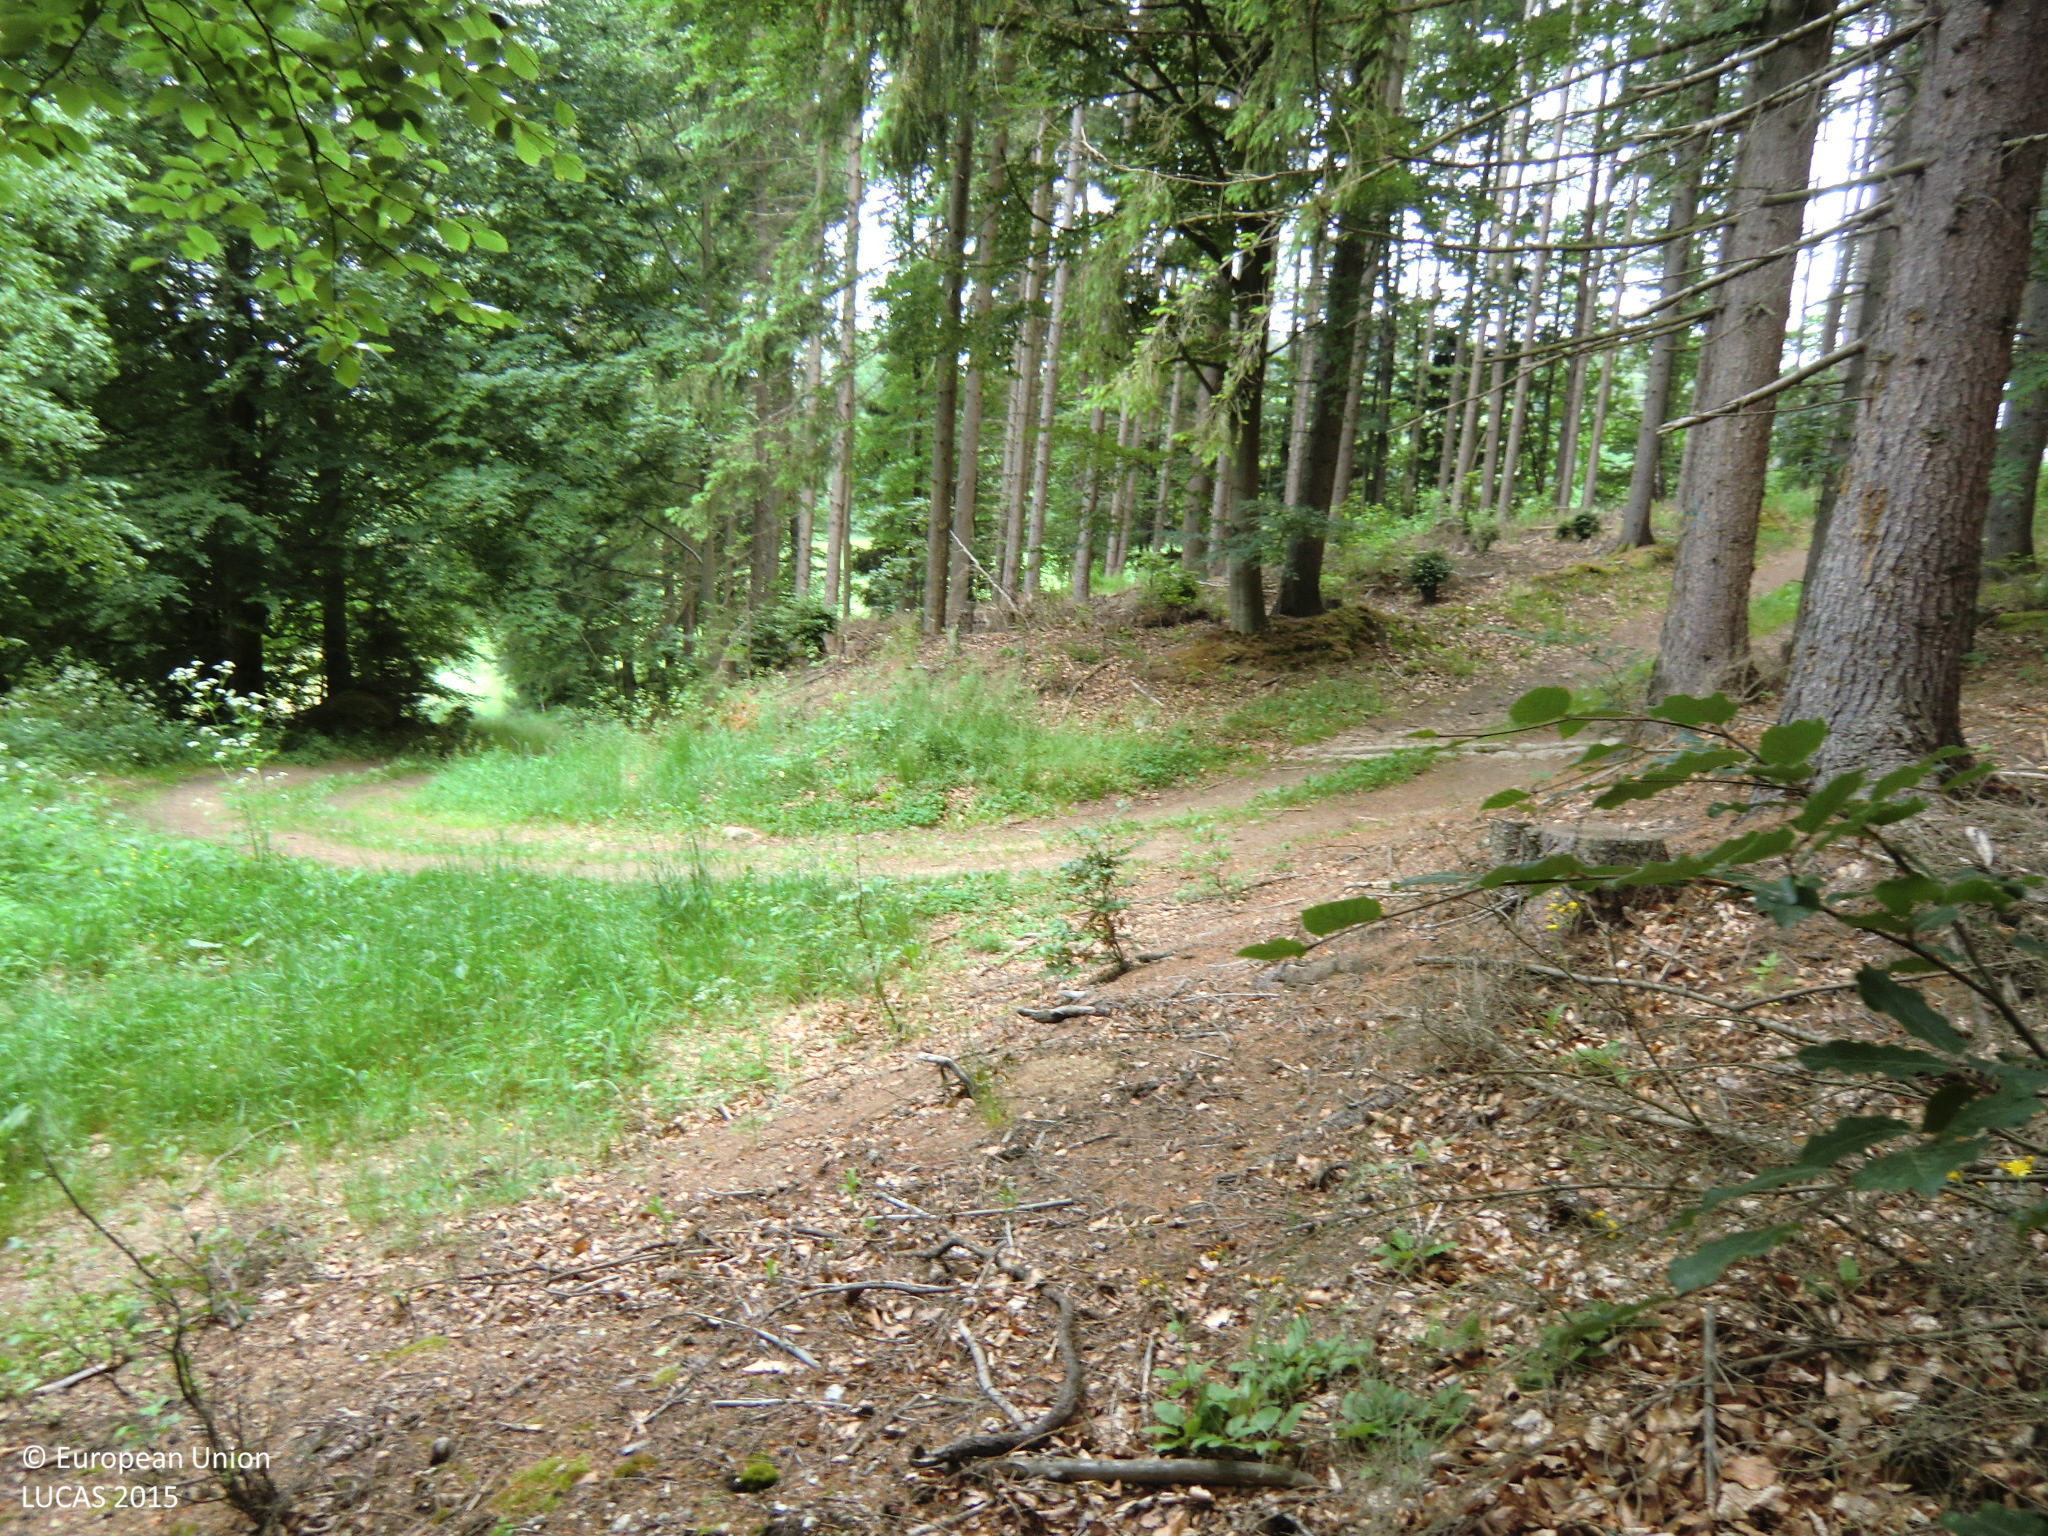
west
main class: Woodland
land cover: Spruce dominated mixed woodland
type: hemiboreal forest and nemoral coniferous forest and mixed broadleaved-coniferous forest
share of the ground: > 75 %
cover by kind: coniferous forest trees 40 %, broadleaved forest trees 40 %, unconsolidated bare surface 15 %, herbaceous plants 5 %
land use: Forestry
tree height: > 5 m
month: June
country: AT
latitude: 48.5966
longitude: 15.0052
